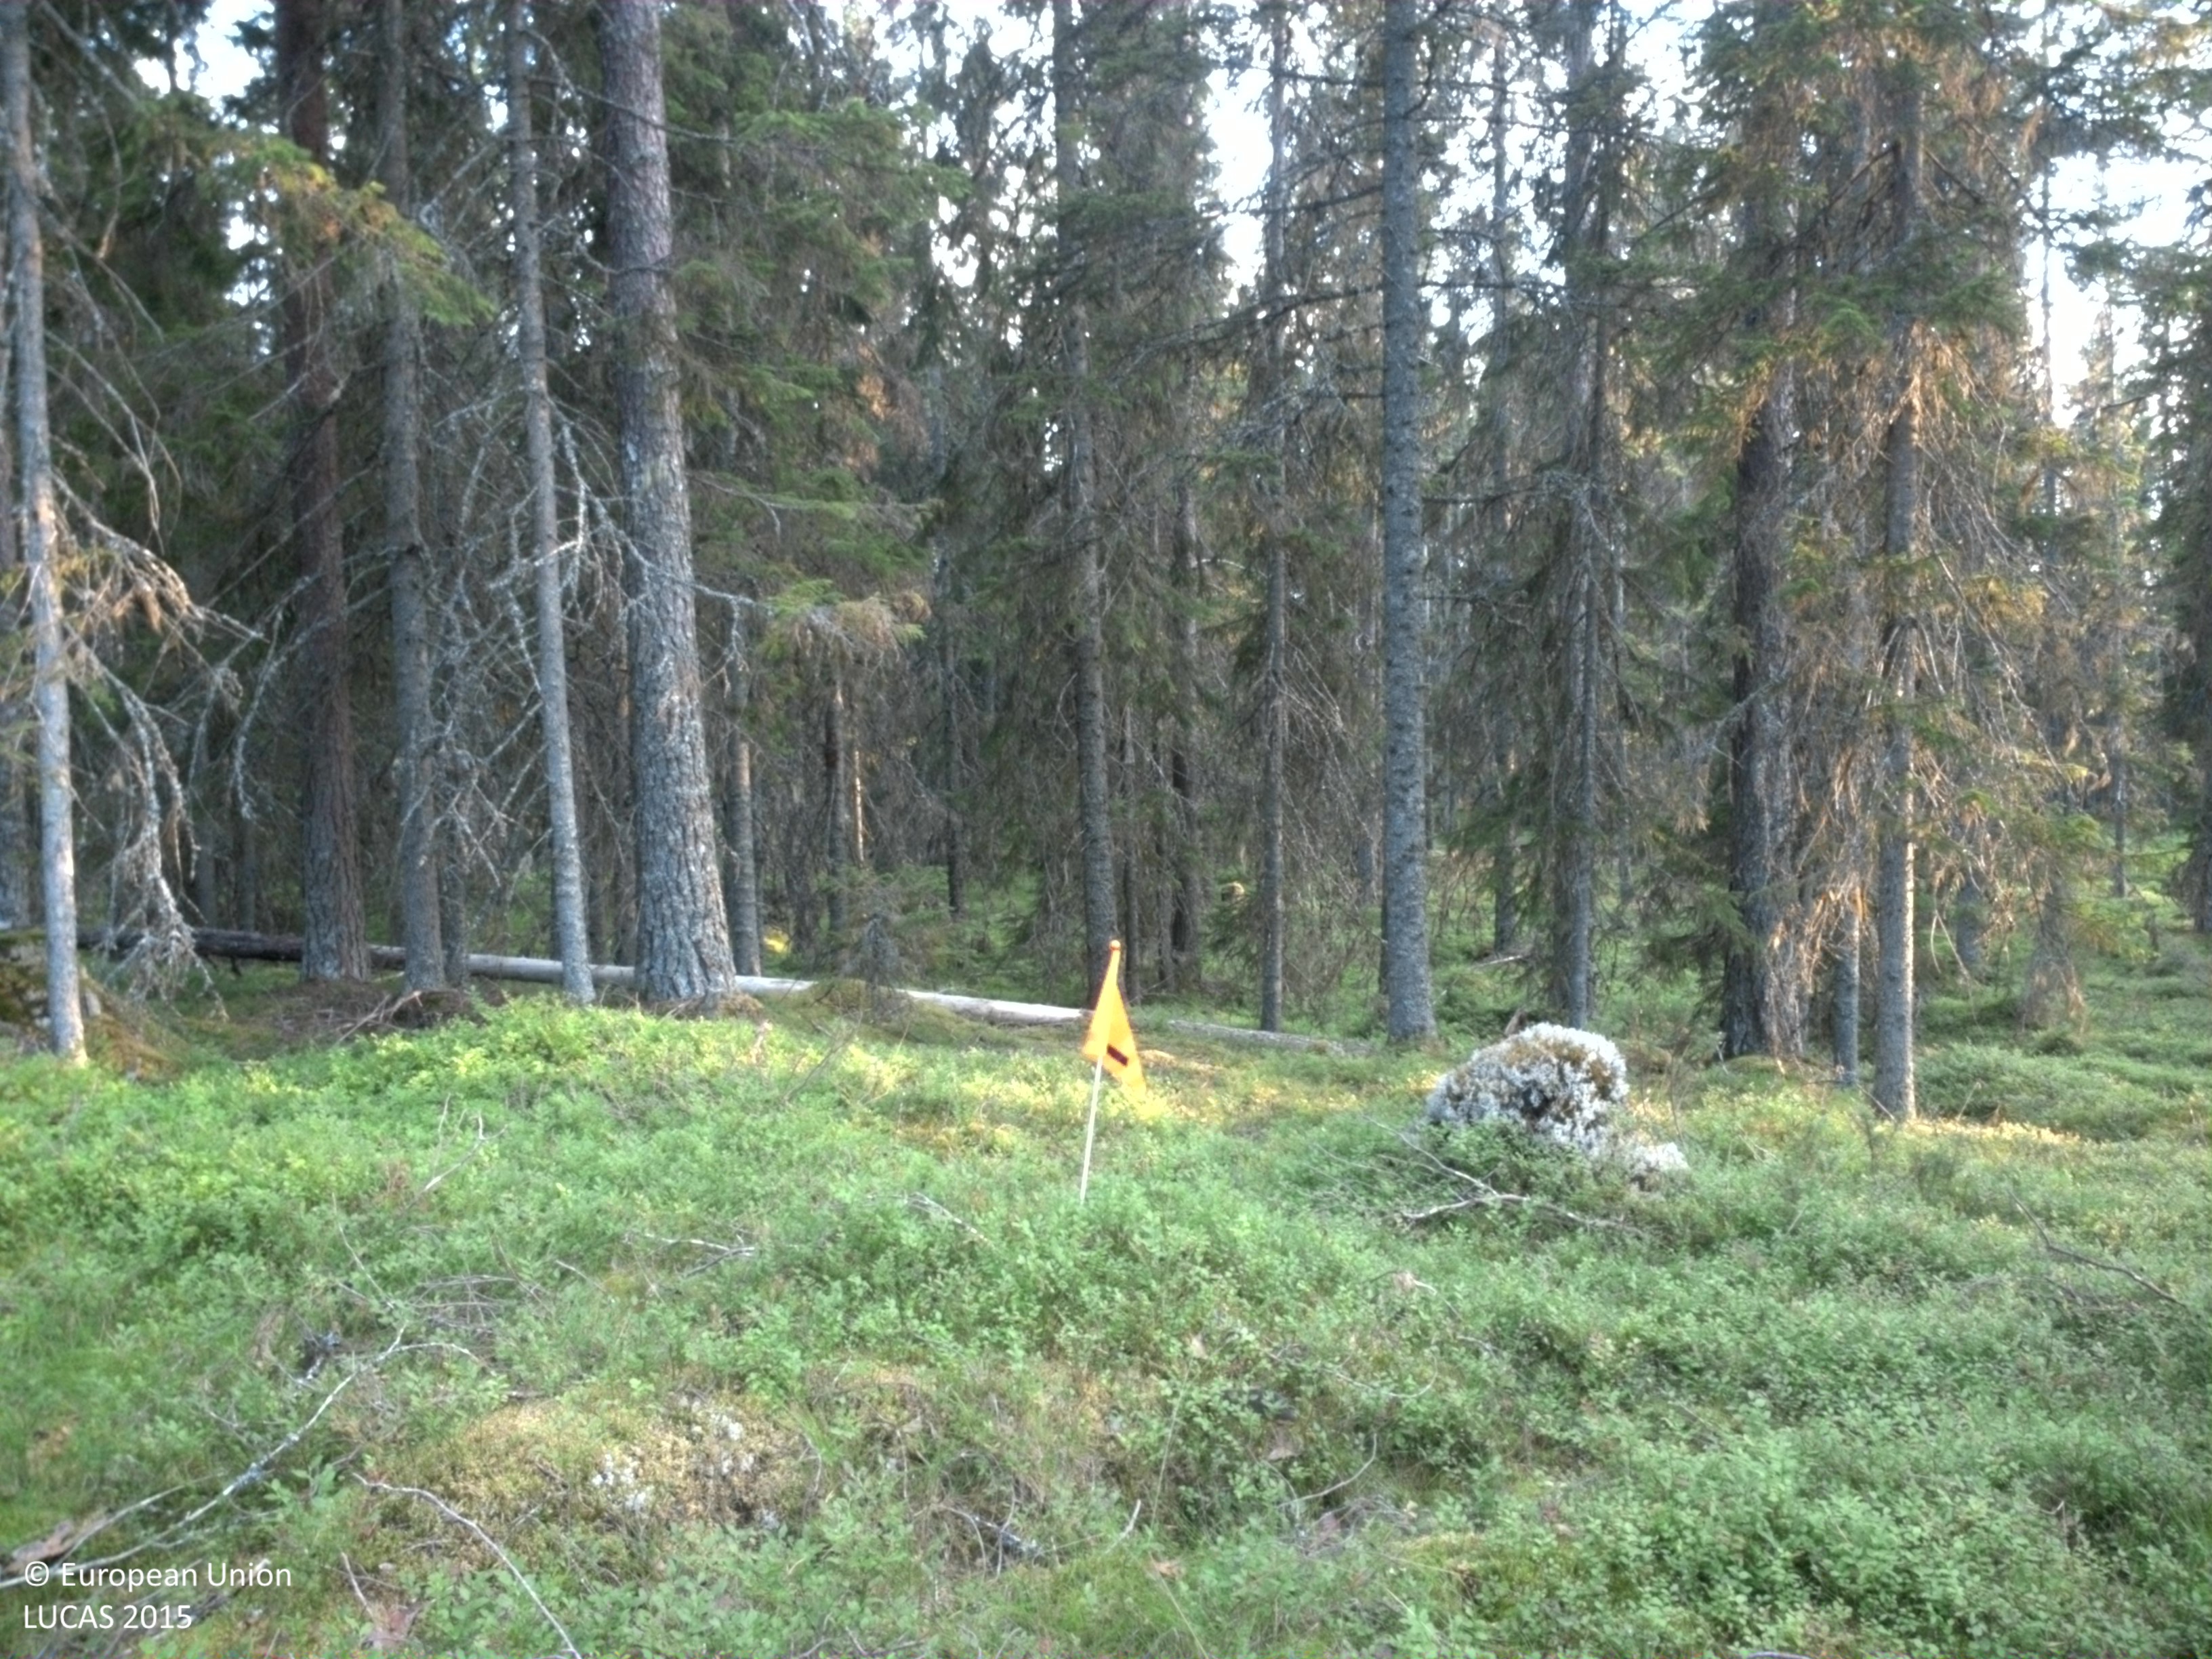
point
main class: Woodland
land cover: Other coniferous woodland
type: boreal forest
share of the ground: 50 - 75 %
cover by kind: coniferous forest trees 65 %, shrubs 25 %, lichens and mosses 10 %
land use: Forestry
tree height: > 5 m
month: August
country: SE
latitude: 61.8165
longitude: 15.2403
